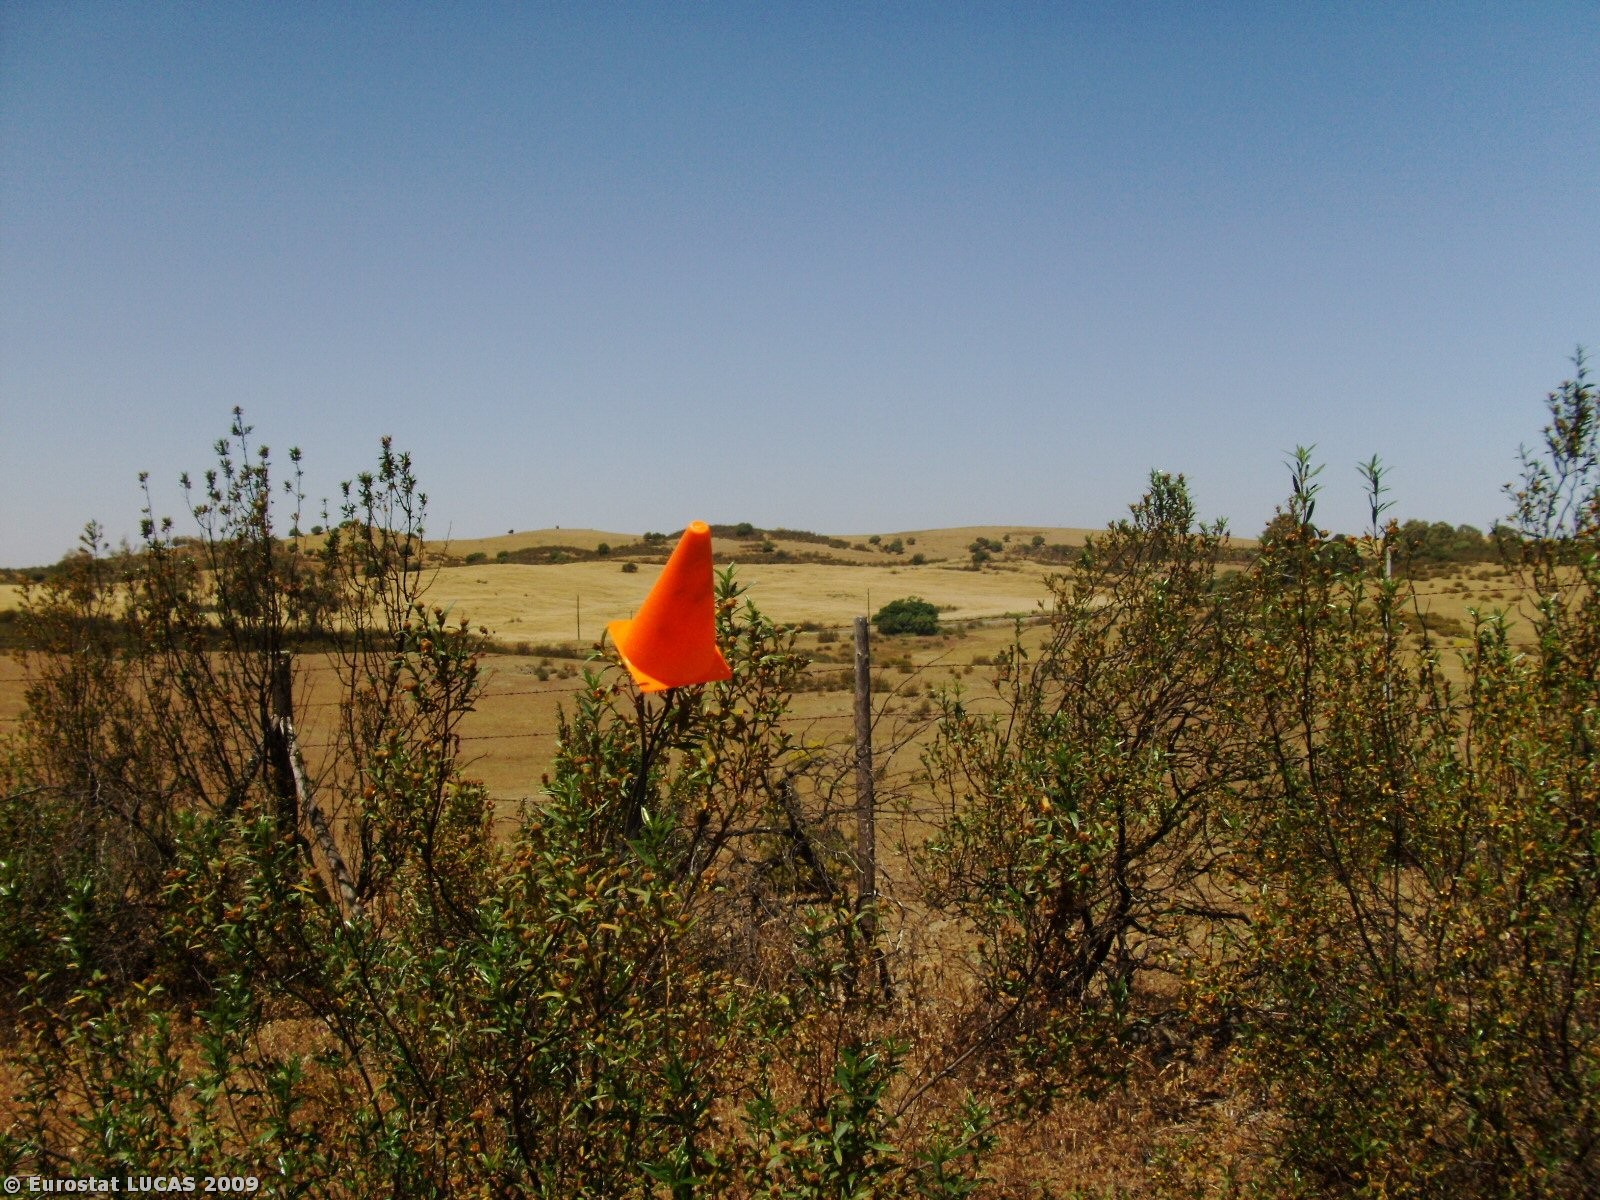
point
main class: Shrubland
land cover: Shrubland without tree cover
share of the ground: 25 - 50 %
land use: Nature reserves
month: May
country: PT
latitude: 37.6221
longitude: -7.7255
